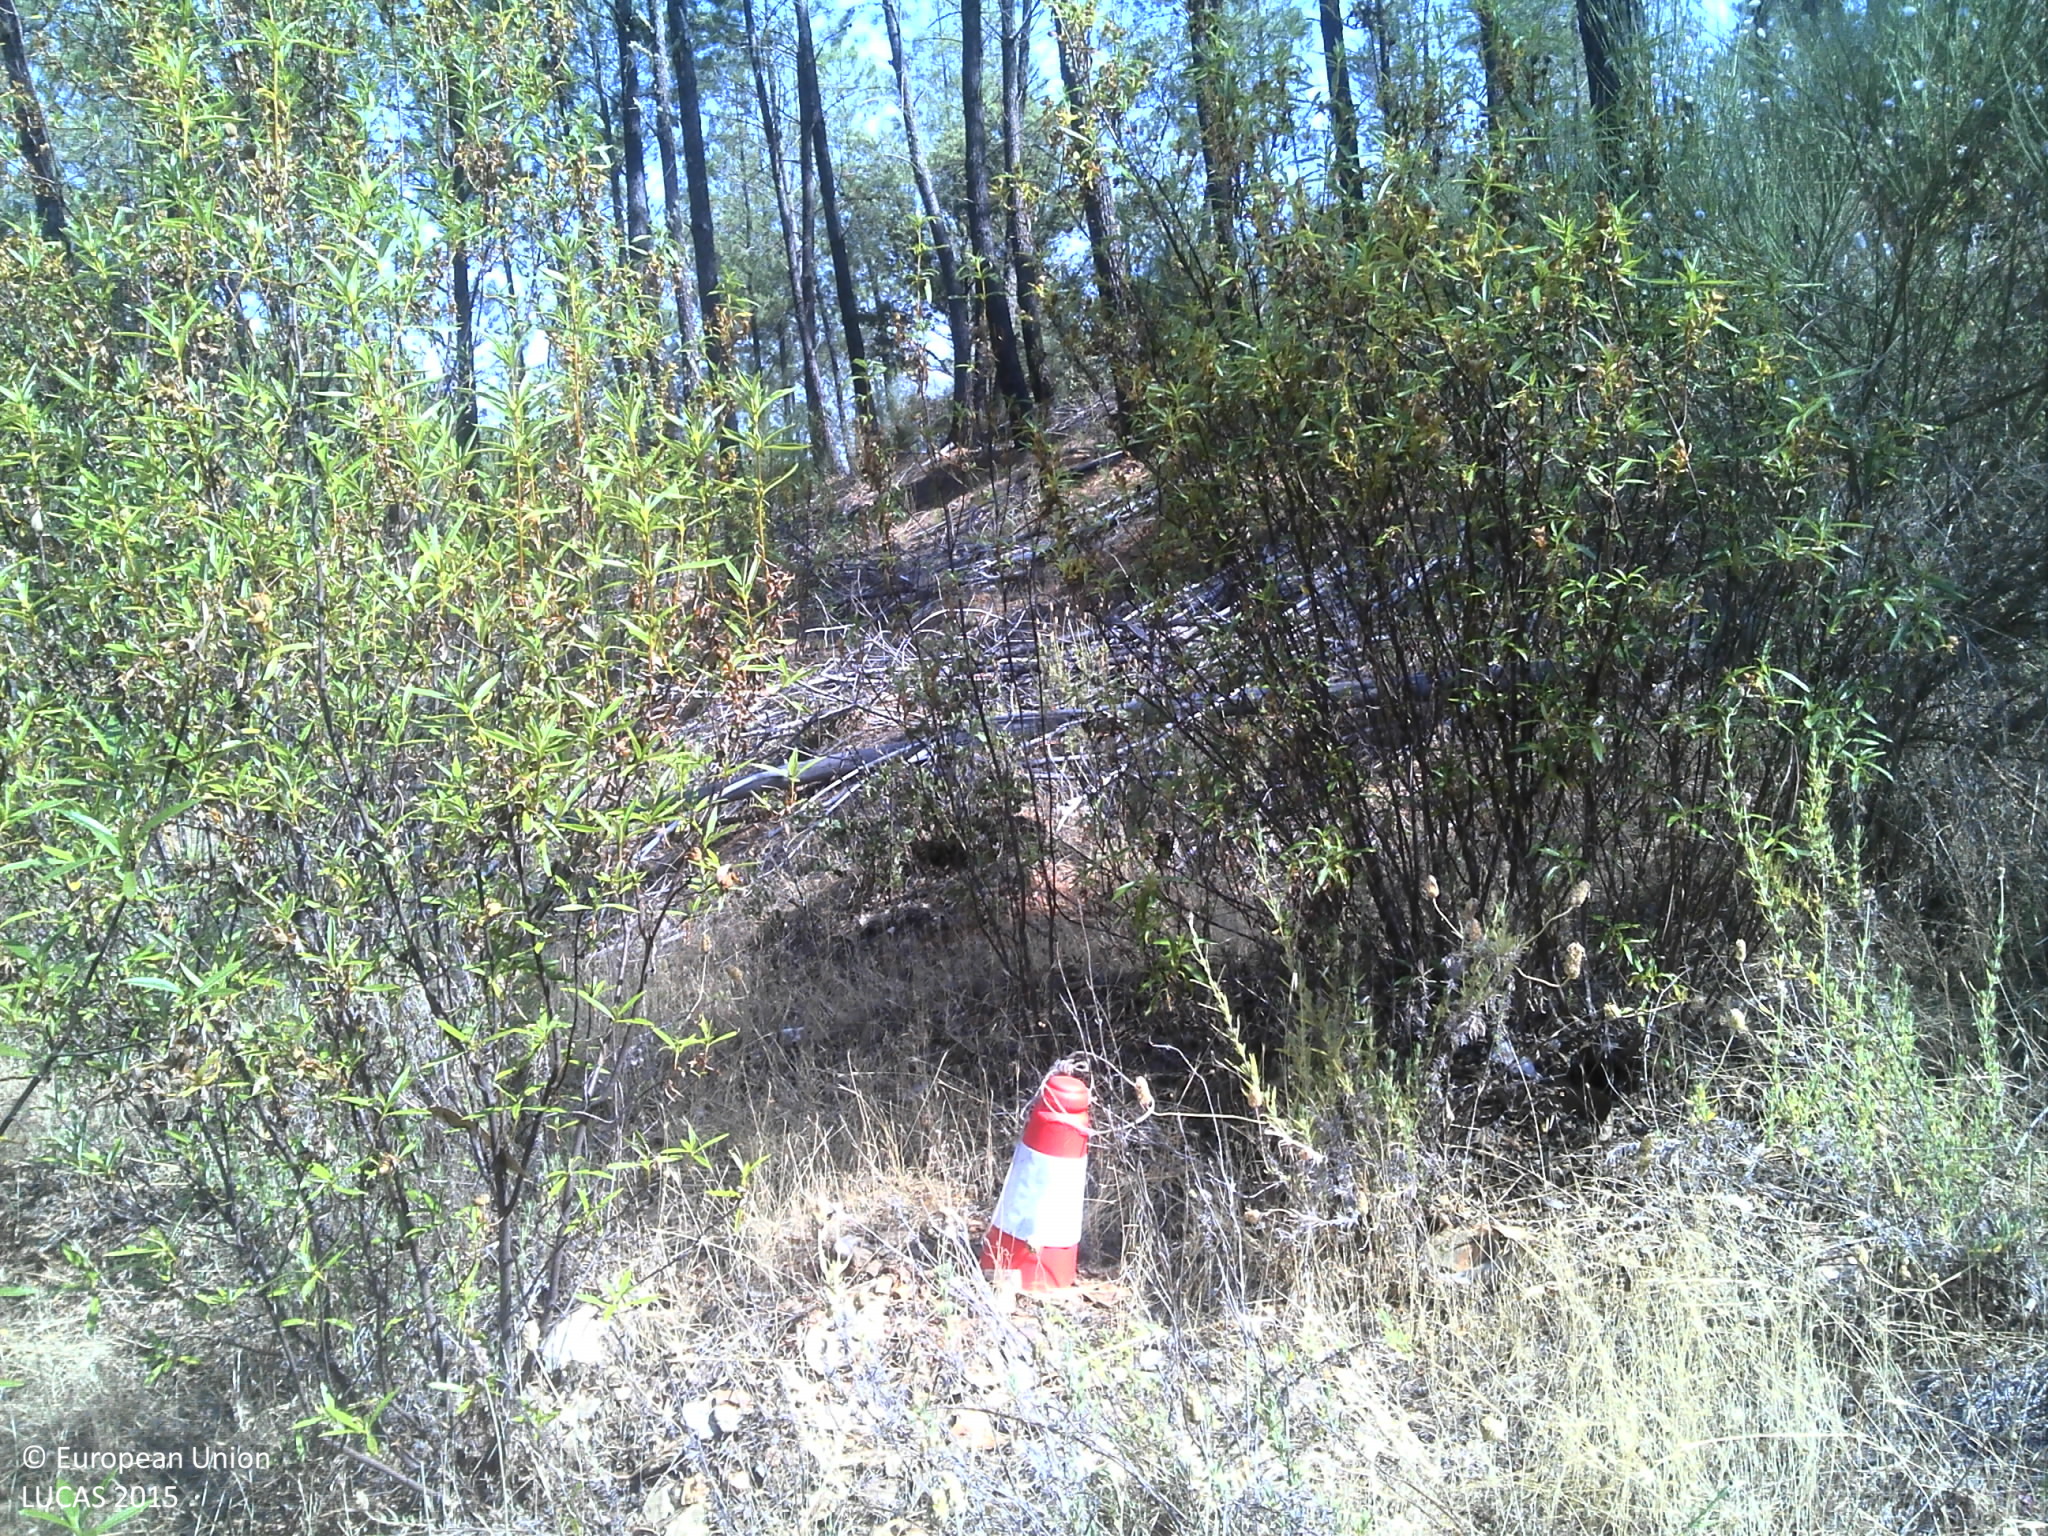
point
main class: Woodland
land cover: Pine dominated coniferous woodland
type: coniferous forest of the mediterranean region
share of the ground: 25 - 50 %
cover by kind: coniferous forest trees 50 %, shrubs 30 %, unconsolidated bare surface 20 %
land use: Forestry
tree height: > 5 m
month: June
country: PT
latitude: 40.1078
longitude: -6.9497
